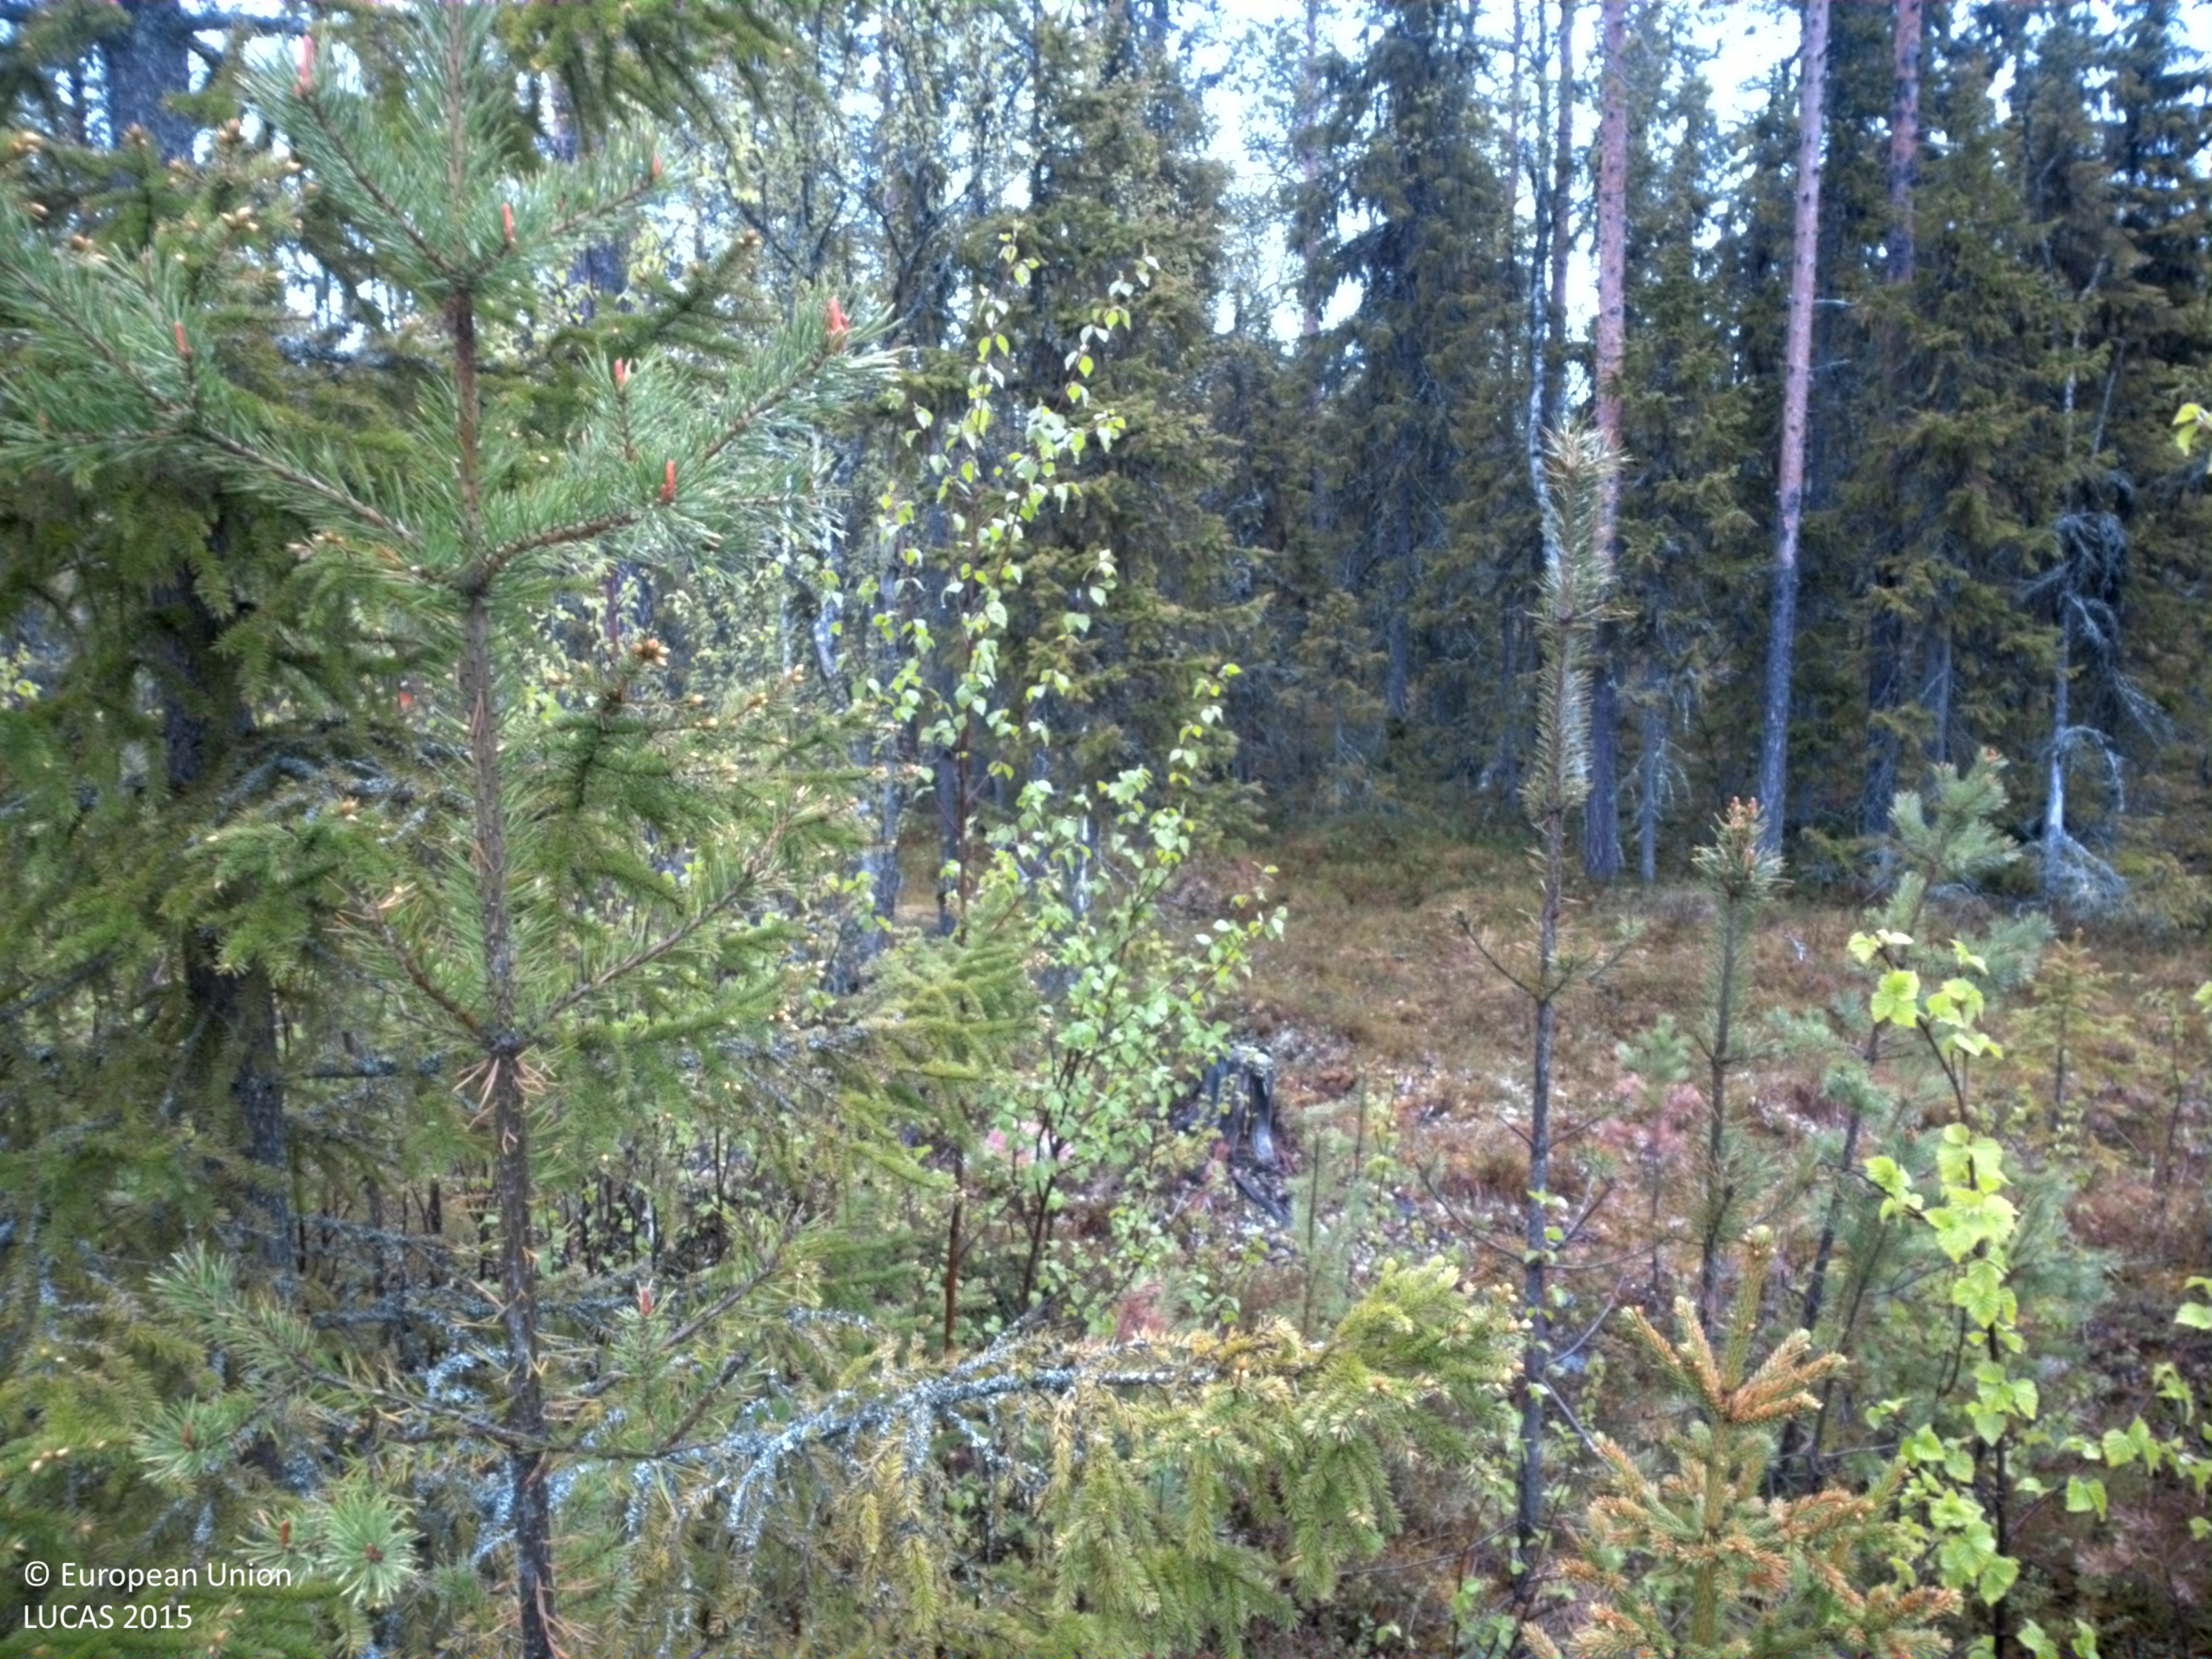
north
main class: Woodland
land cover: Pine dominated mixed woodland
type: boreal forest
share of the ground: 25 - 50 %
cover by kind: coniferous forest trees 30 %, herbaceous plants 25 %, broadleaved forest trees 15 %, lichens and mosses 15 %, unconsolidated bare surface 10 %, shrubs 5 %
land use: Forestry
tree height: < 5 m
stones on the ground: 25 - 50 %
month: June
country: SE
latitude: 64.4420
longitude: 17.4256
